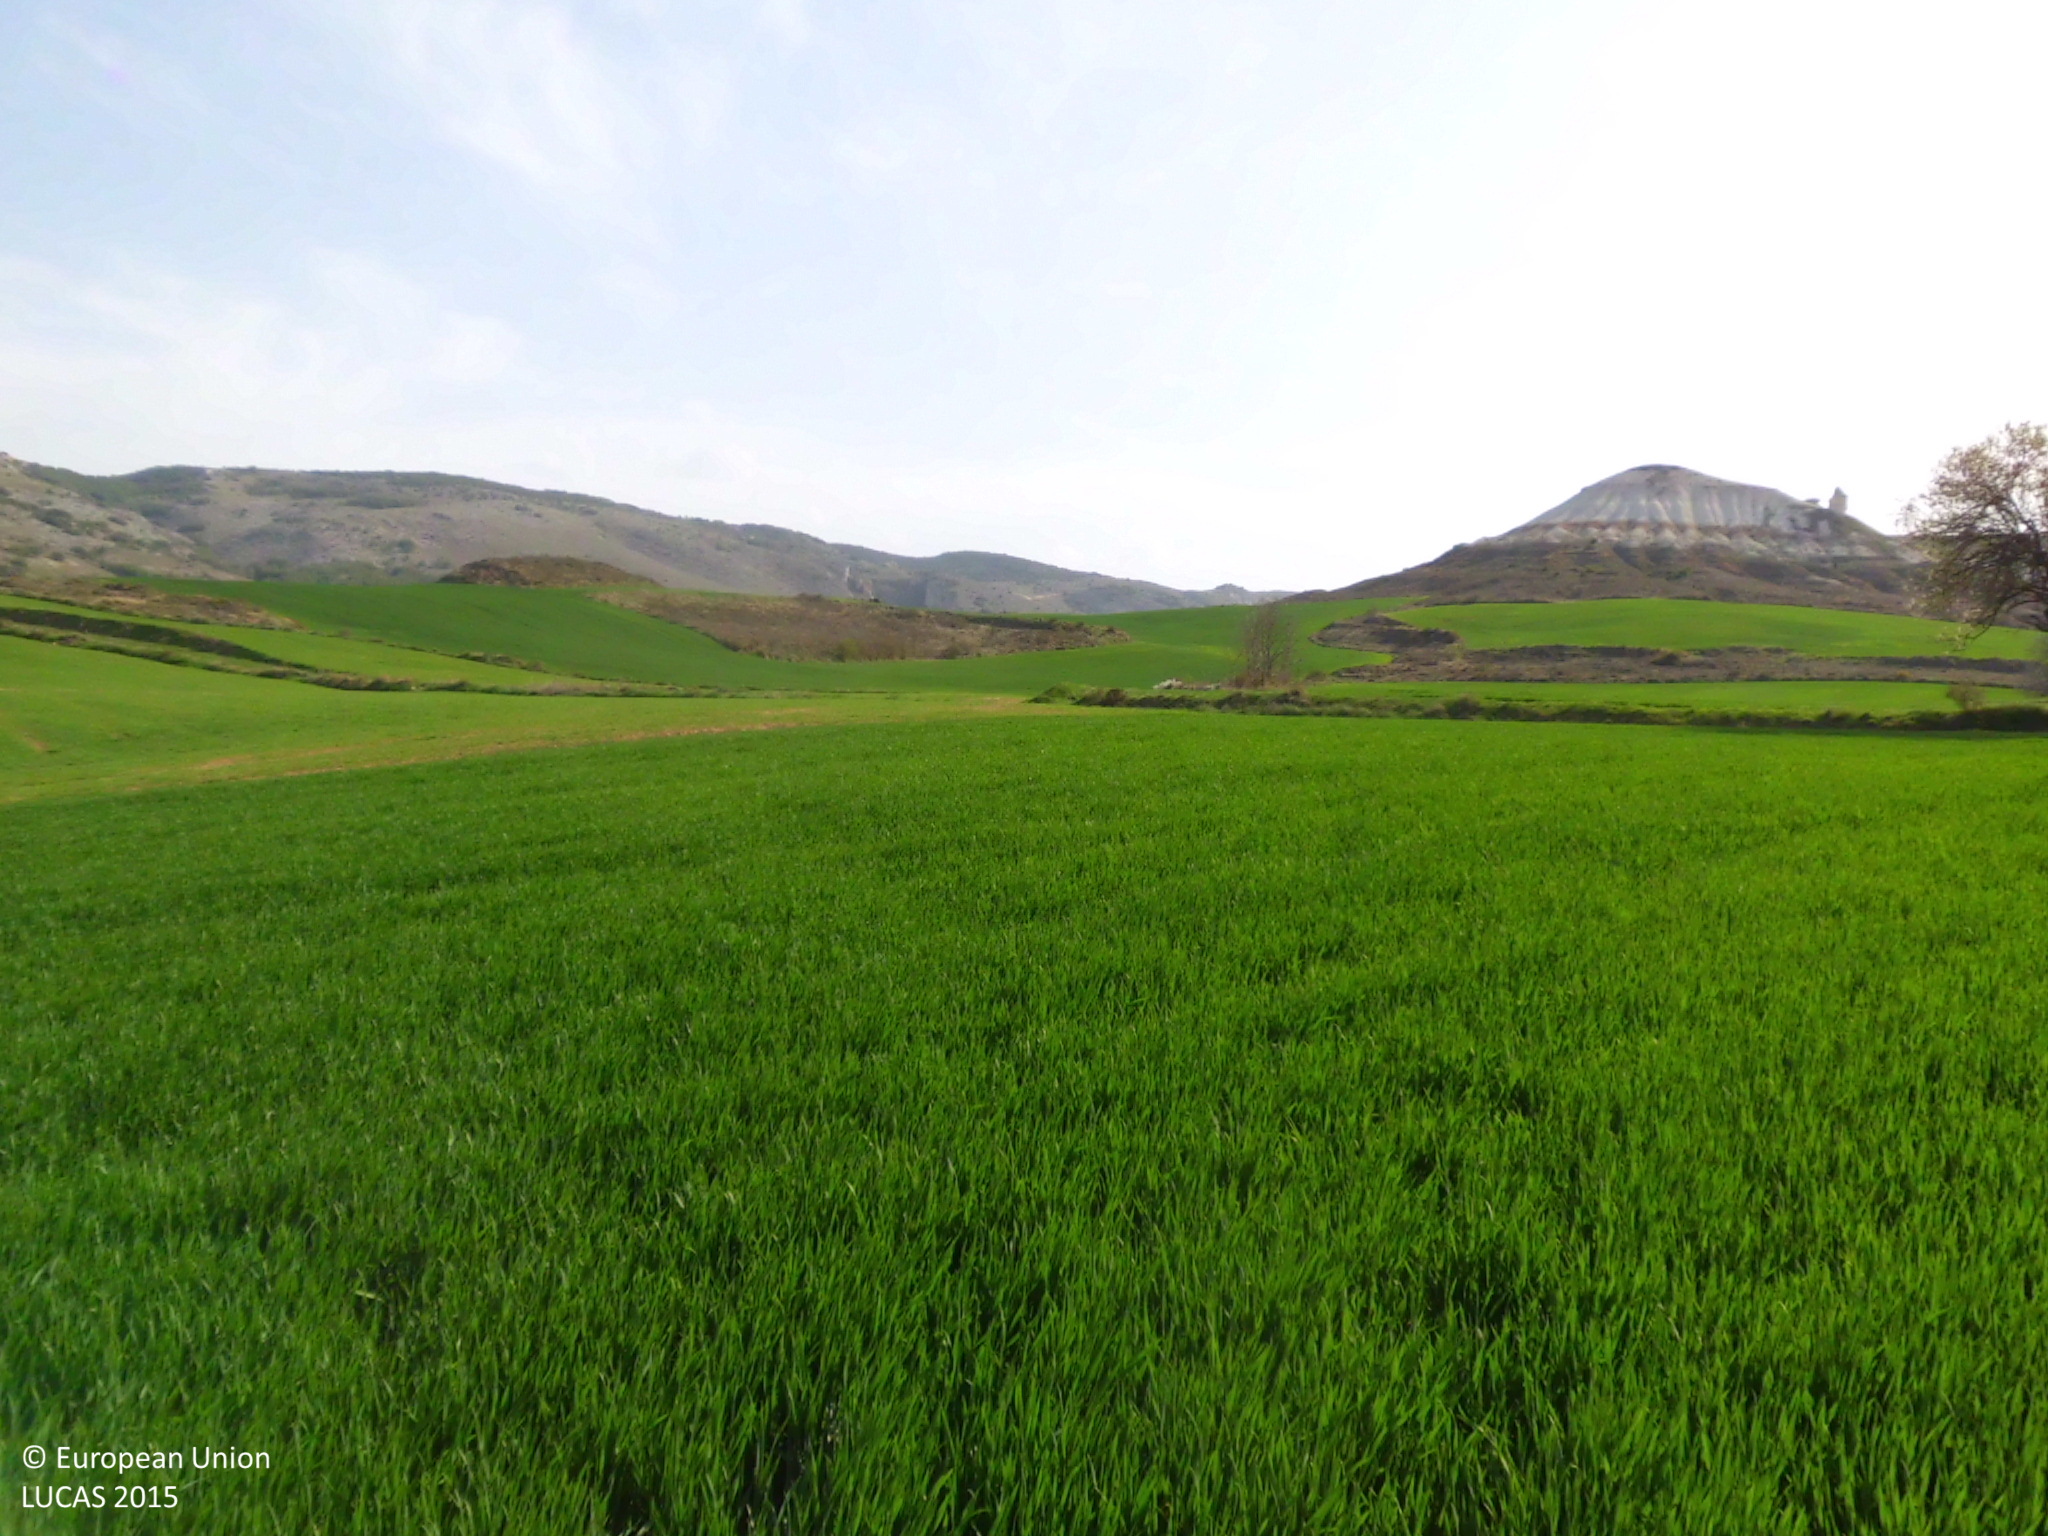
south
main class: Cropland
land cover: Common wheat
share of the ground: > 75 %
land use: Agriculture (excluding fallow land and kitchen gardens)
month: April
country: ES
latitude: 42.5752
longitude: -3.4485
